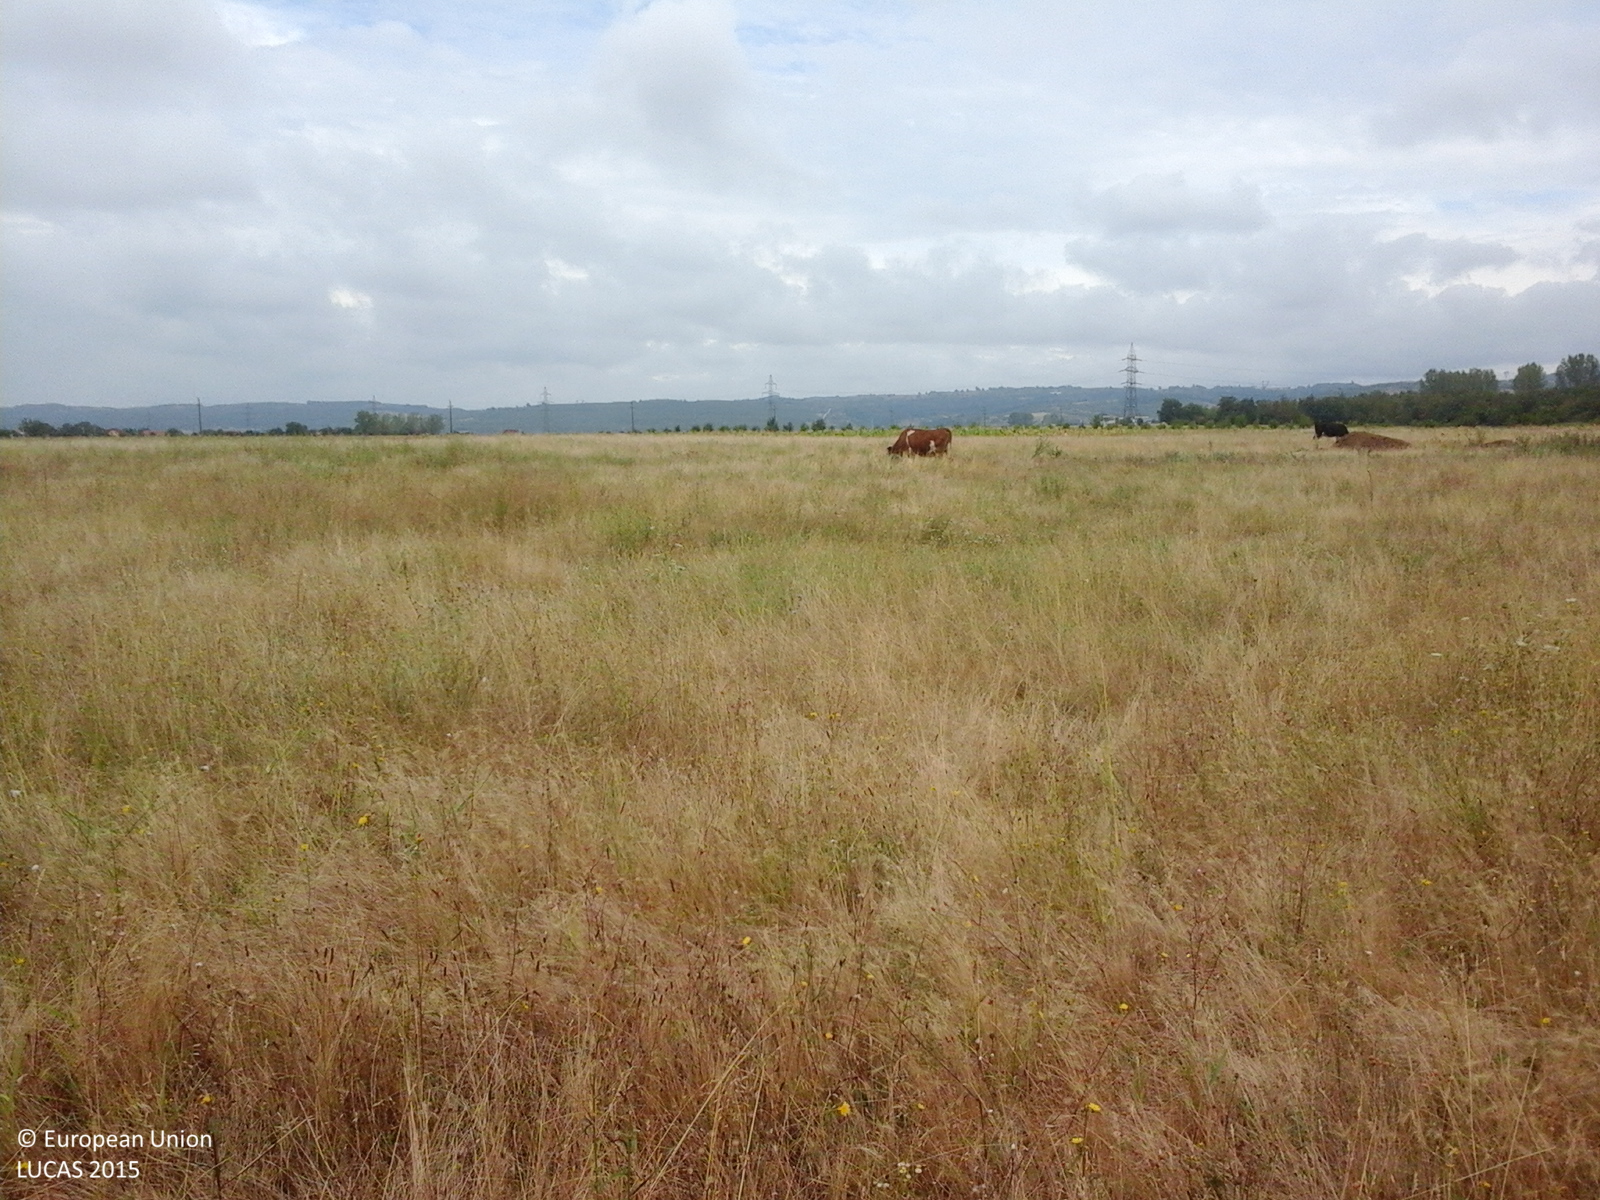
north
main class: Grassland
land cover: Grassland without tree/shrub cover
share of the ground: > 75 %
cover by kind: herbaceous plants 100 %
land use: Agriculture (excluding fallow land and kitchen gardens)
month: August
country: RO
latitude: 44.6204
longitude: 22.7337
